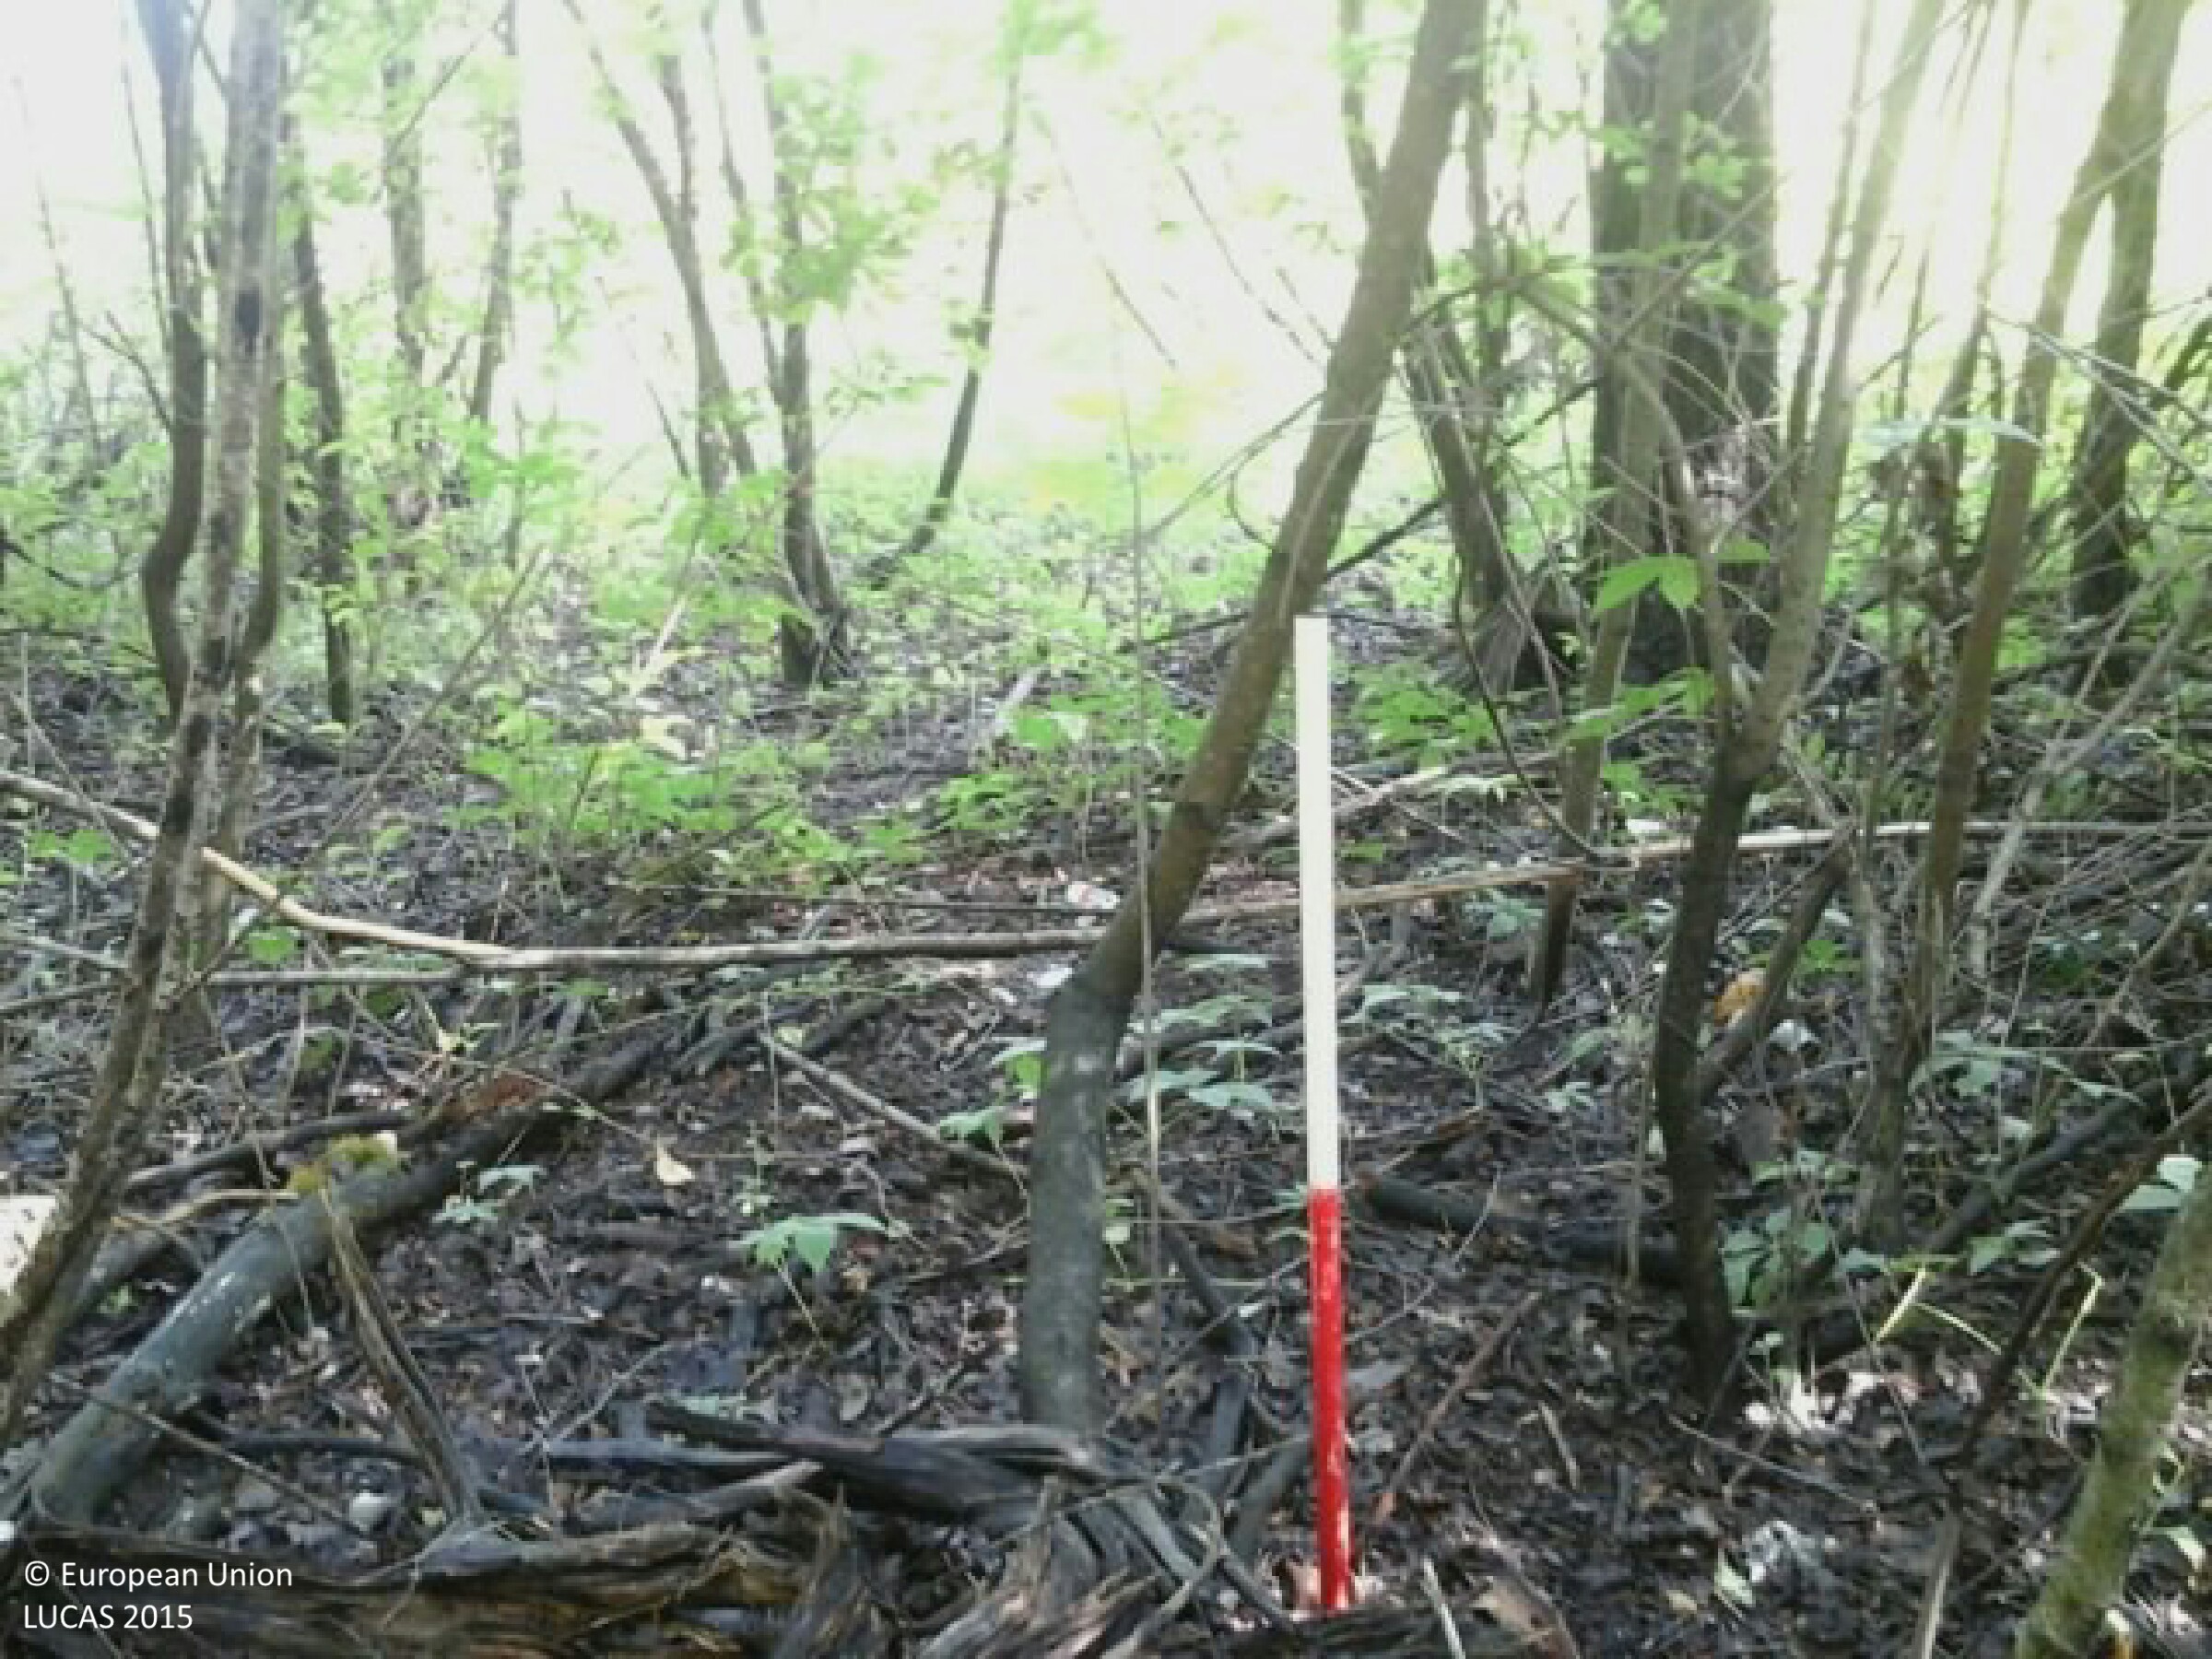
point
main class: Woodland
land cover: Broadleaved woodland
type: mesophytic deciduous forest
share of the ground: > 75 %
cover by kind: broadleaved forest trees 85 %, shrubs 10 %, herbaceous plants 5 %
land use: Forestry
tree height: > 5 m
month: August
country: HU
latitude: 47.1613
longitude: 19.6906
